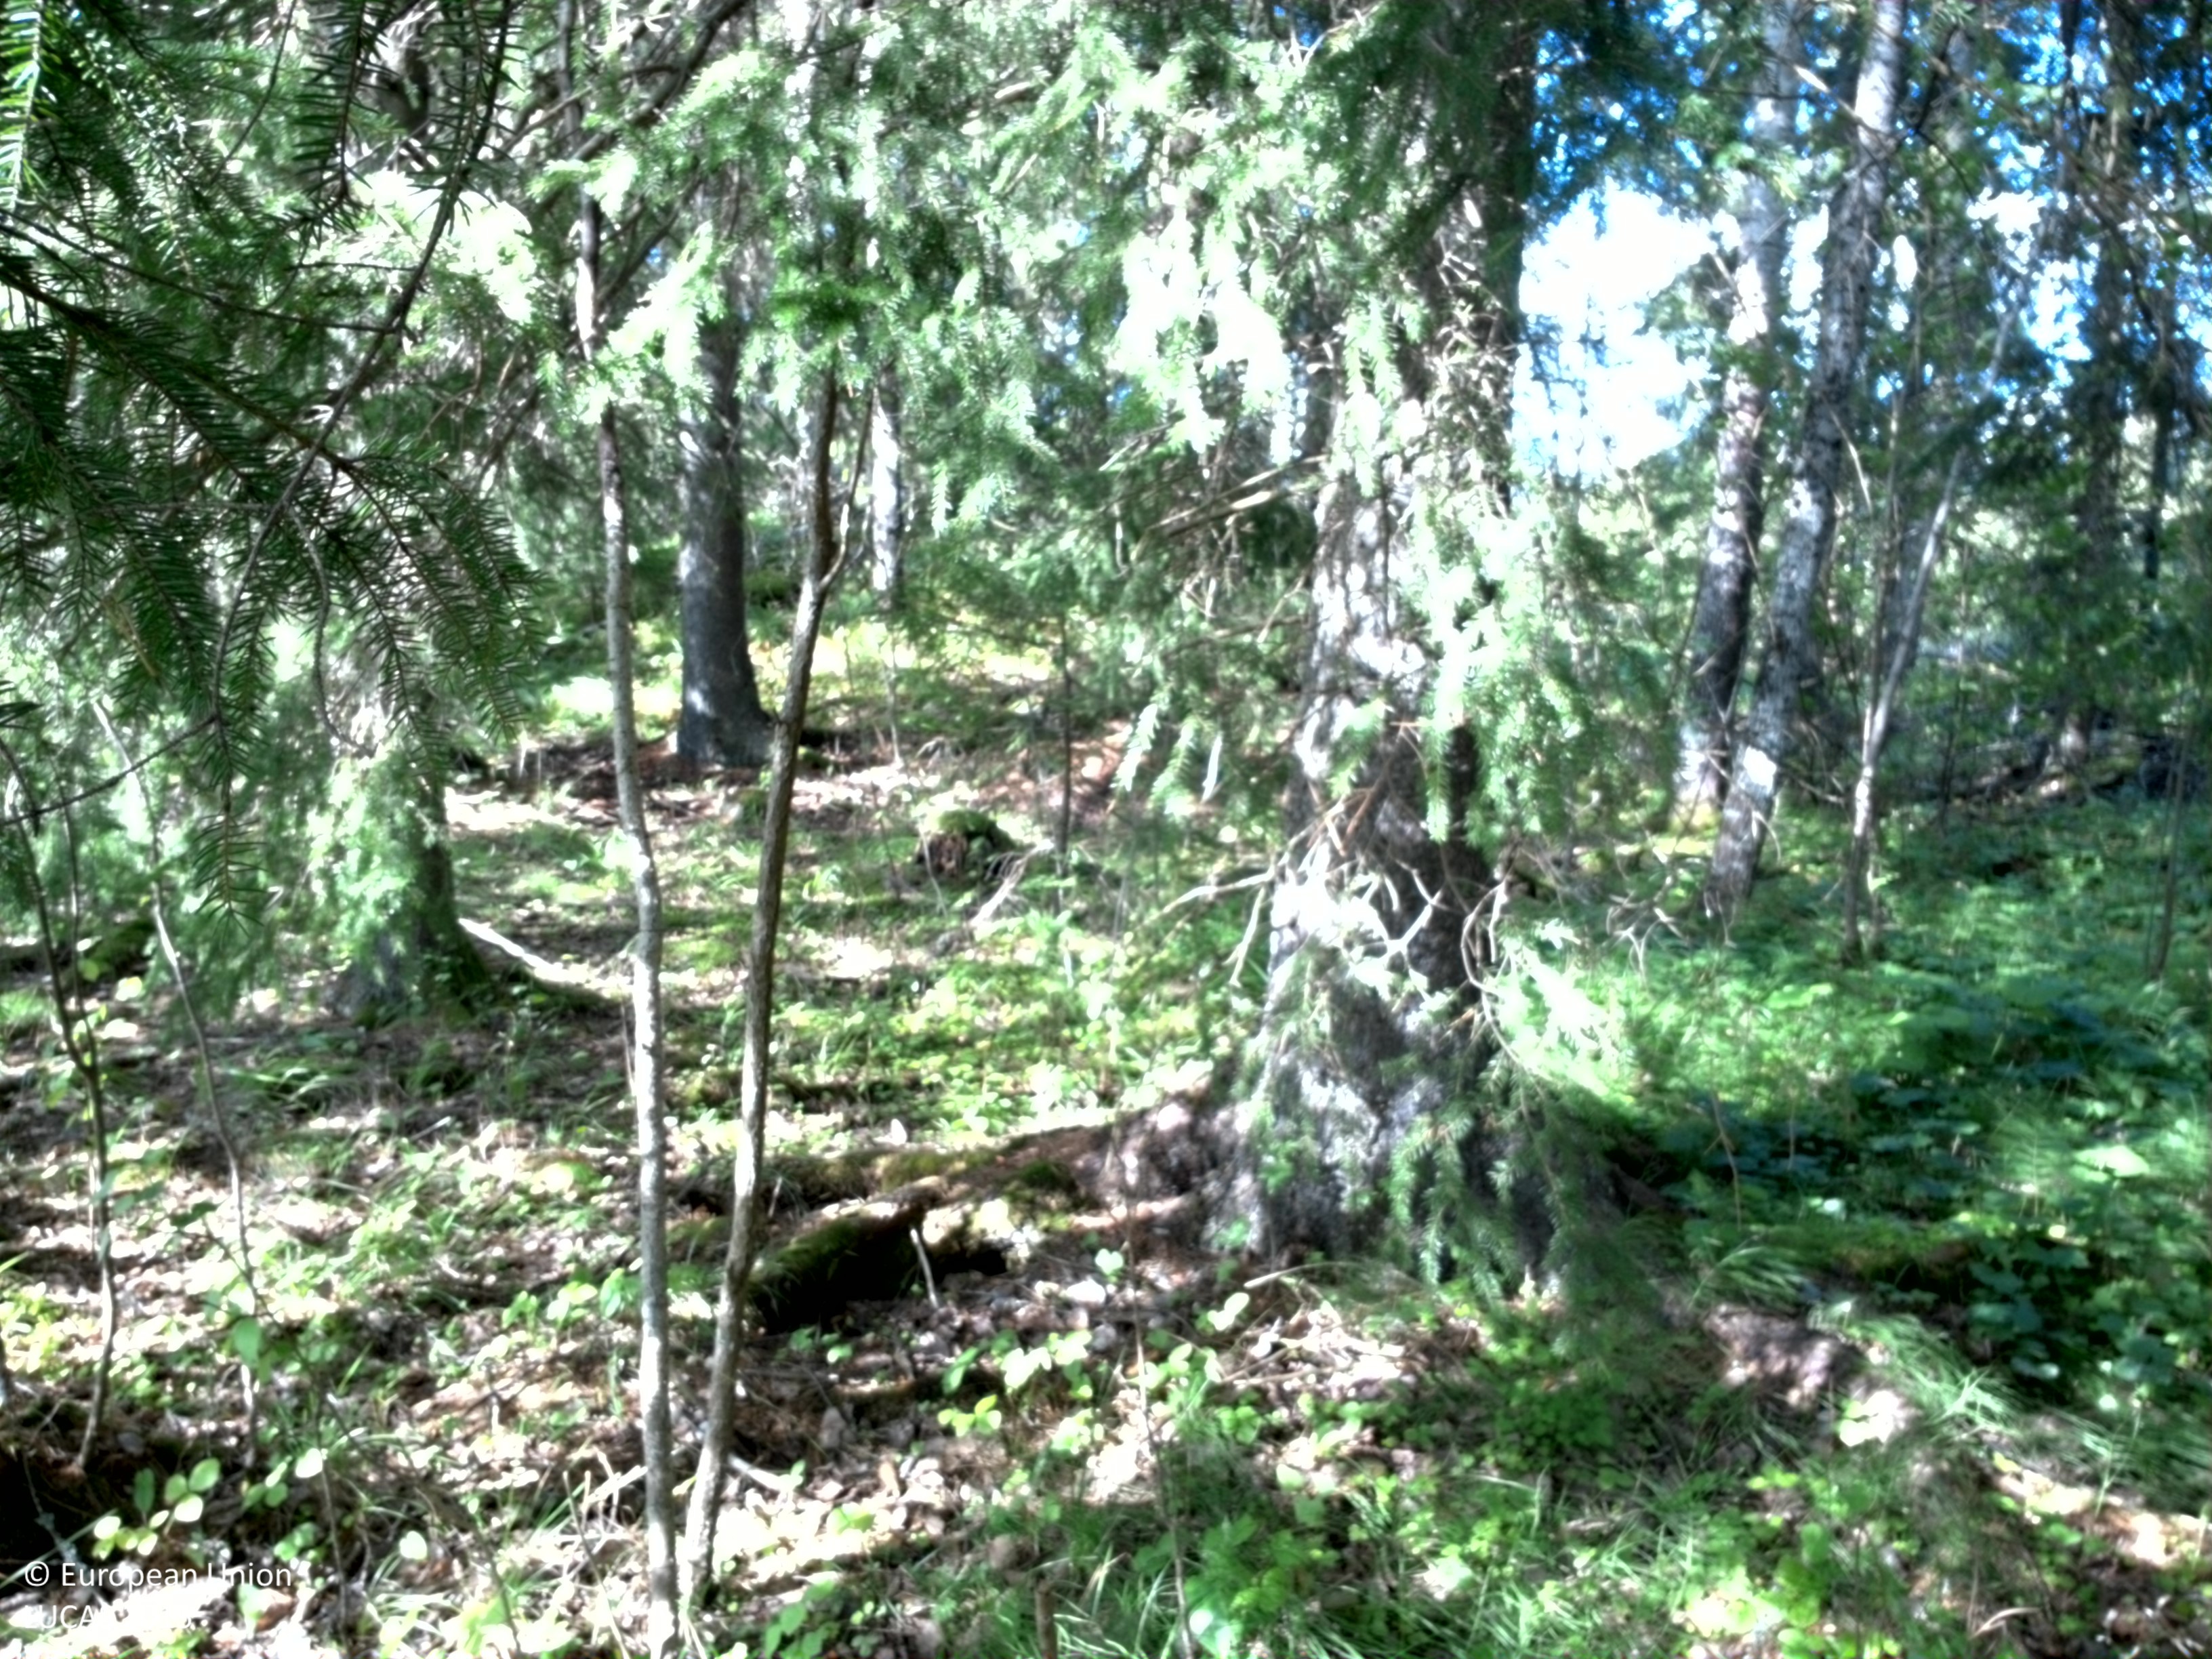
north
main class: Woodland
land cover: Spruce dominated mixed woodland
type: boreal forest
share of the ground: > 75 %
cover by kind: coniferous forest trees 60 %, broadleaved forest trees 20 %, herbaceous plants 20 %
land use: Forestry
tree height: > 5 m
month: August
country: SE
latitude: 59.9769
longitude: 16.4948
